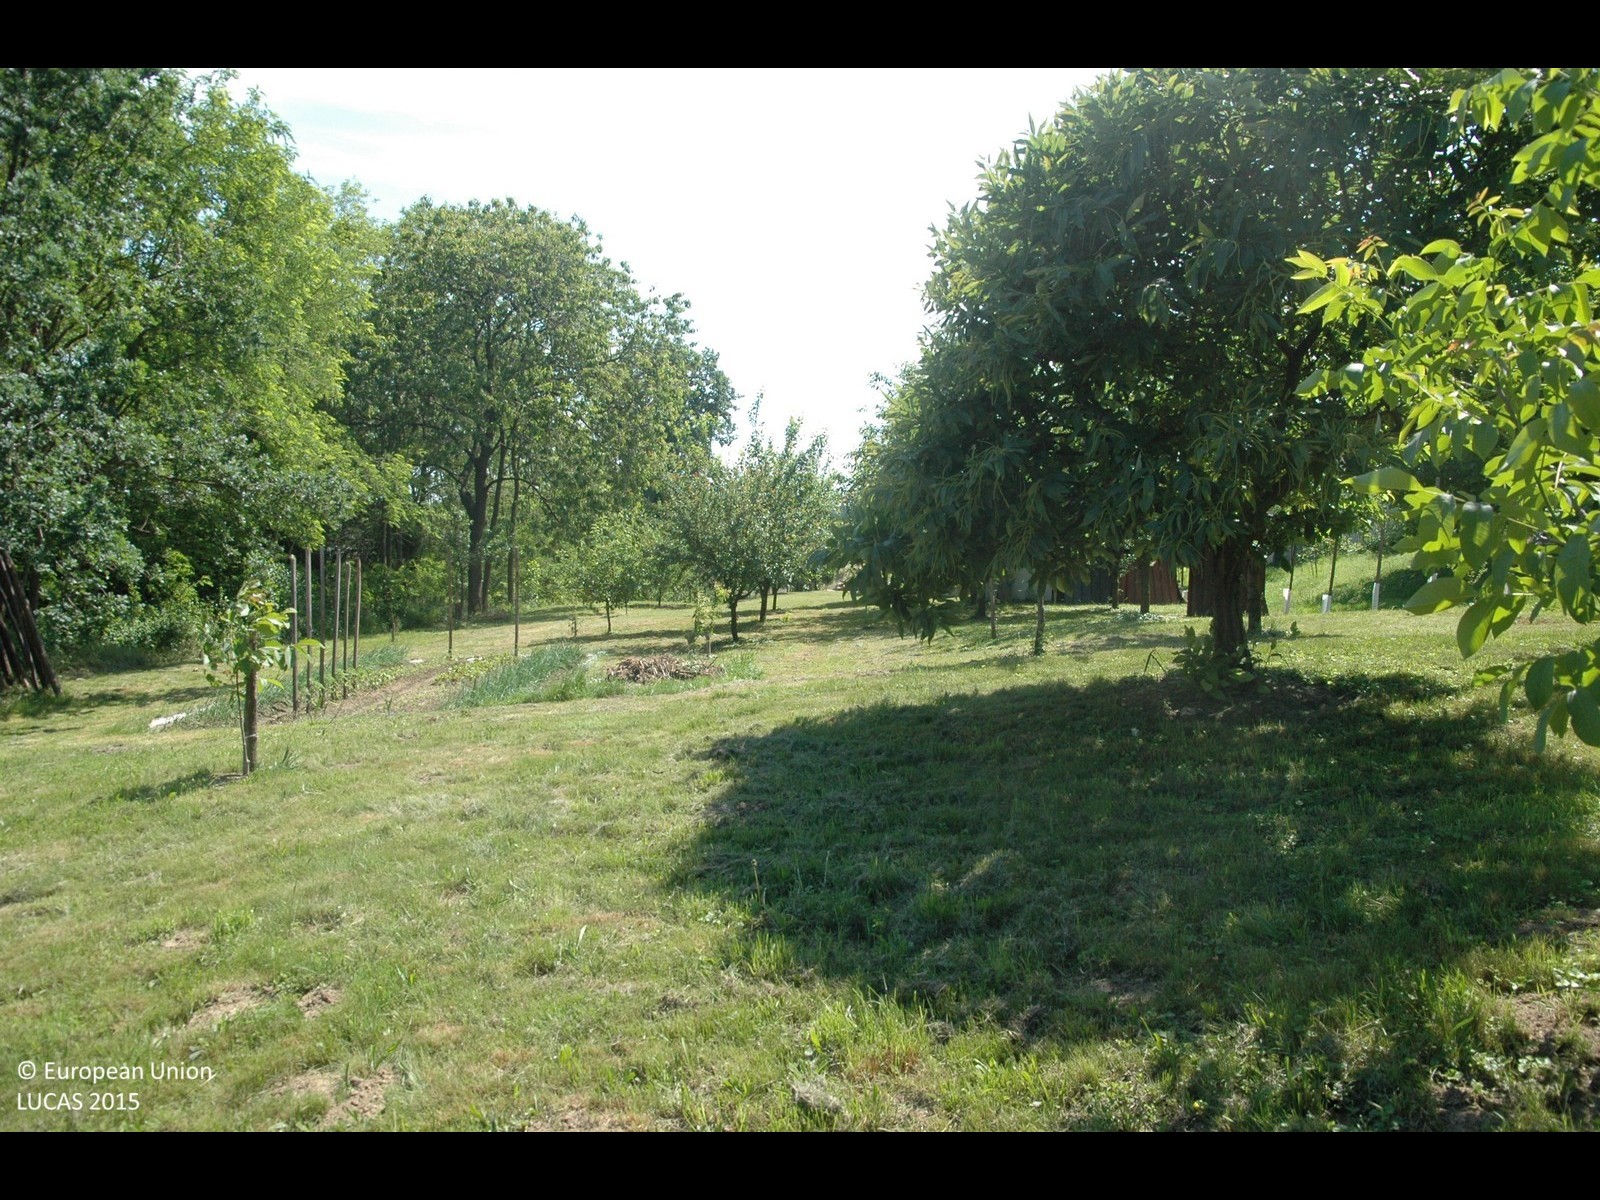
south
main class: Cropland
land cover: Nuts trees
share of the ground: 10 - 25 %
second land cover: Grassland without tree/shrub cover
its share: 50 - 75 %
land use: Agriculture (excluding fallow land and kitchen gardens)
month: May
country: HR
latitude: 46.4849
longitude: 16.3969
